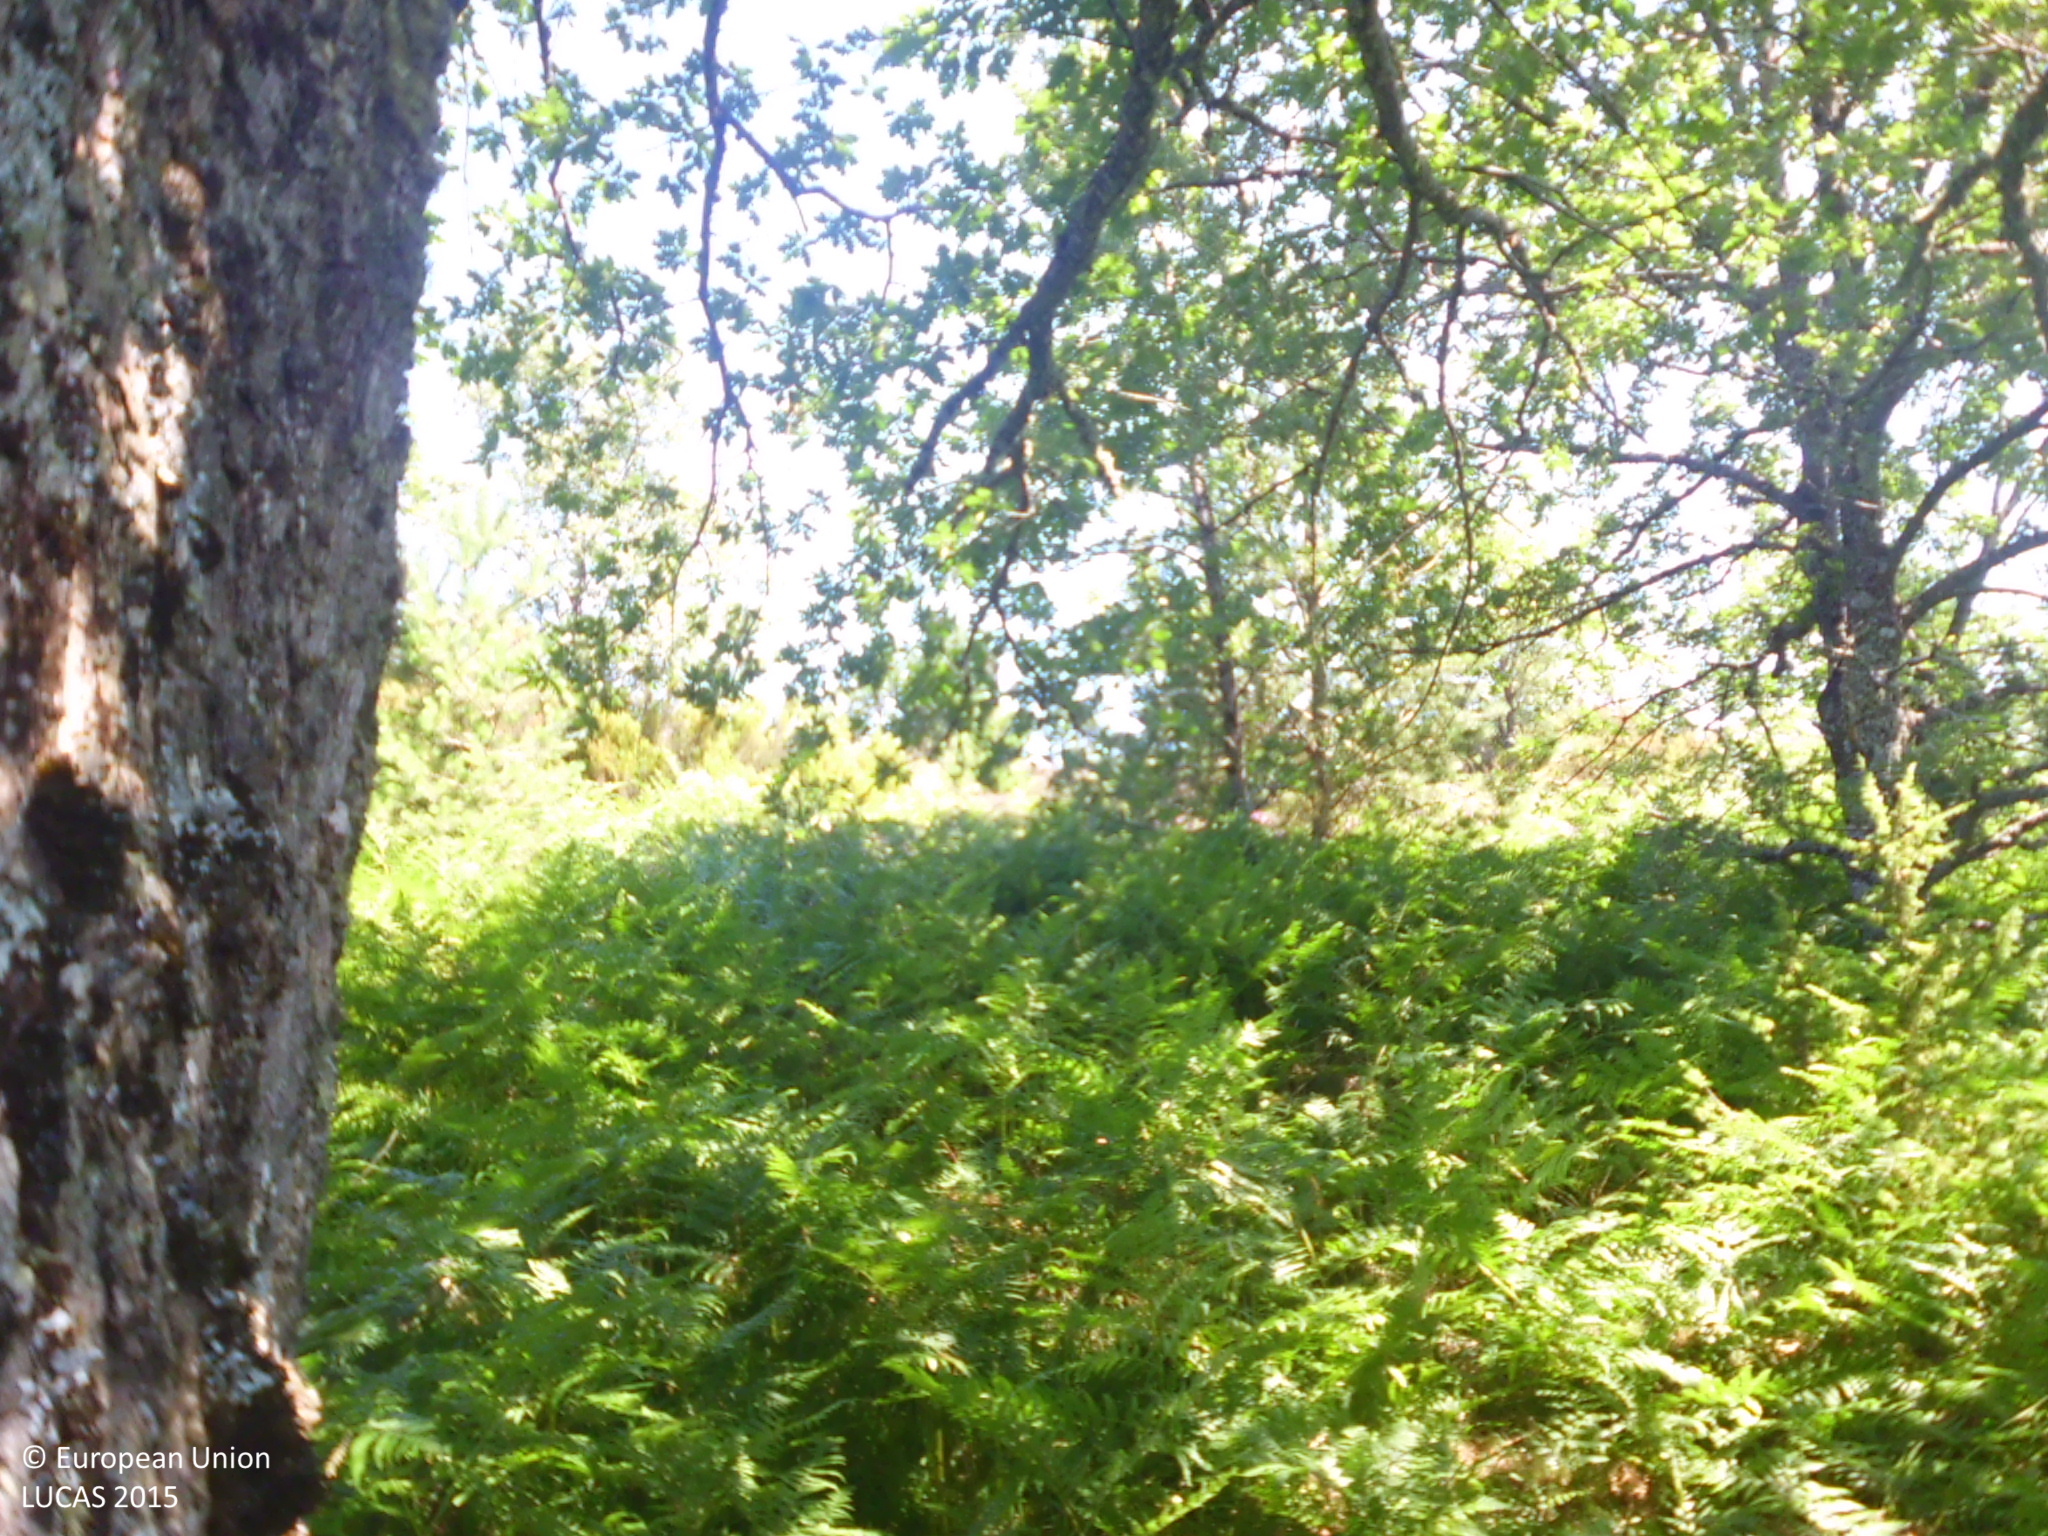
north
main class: Woodland
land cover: Broadleaved woodland
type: acidophilous oak and oak-birch forest
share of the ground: 10 - 25 %
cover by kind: shrubs 60 %, broadleaved forest trees 20 %, herbaceous plants 20 %
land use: Agriculture (excluding fallow land and kitchen gardens)
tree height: > 5 m
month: July
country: ES
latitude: 42.3155
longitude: -3.3405
